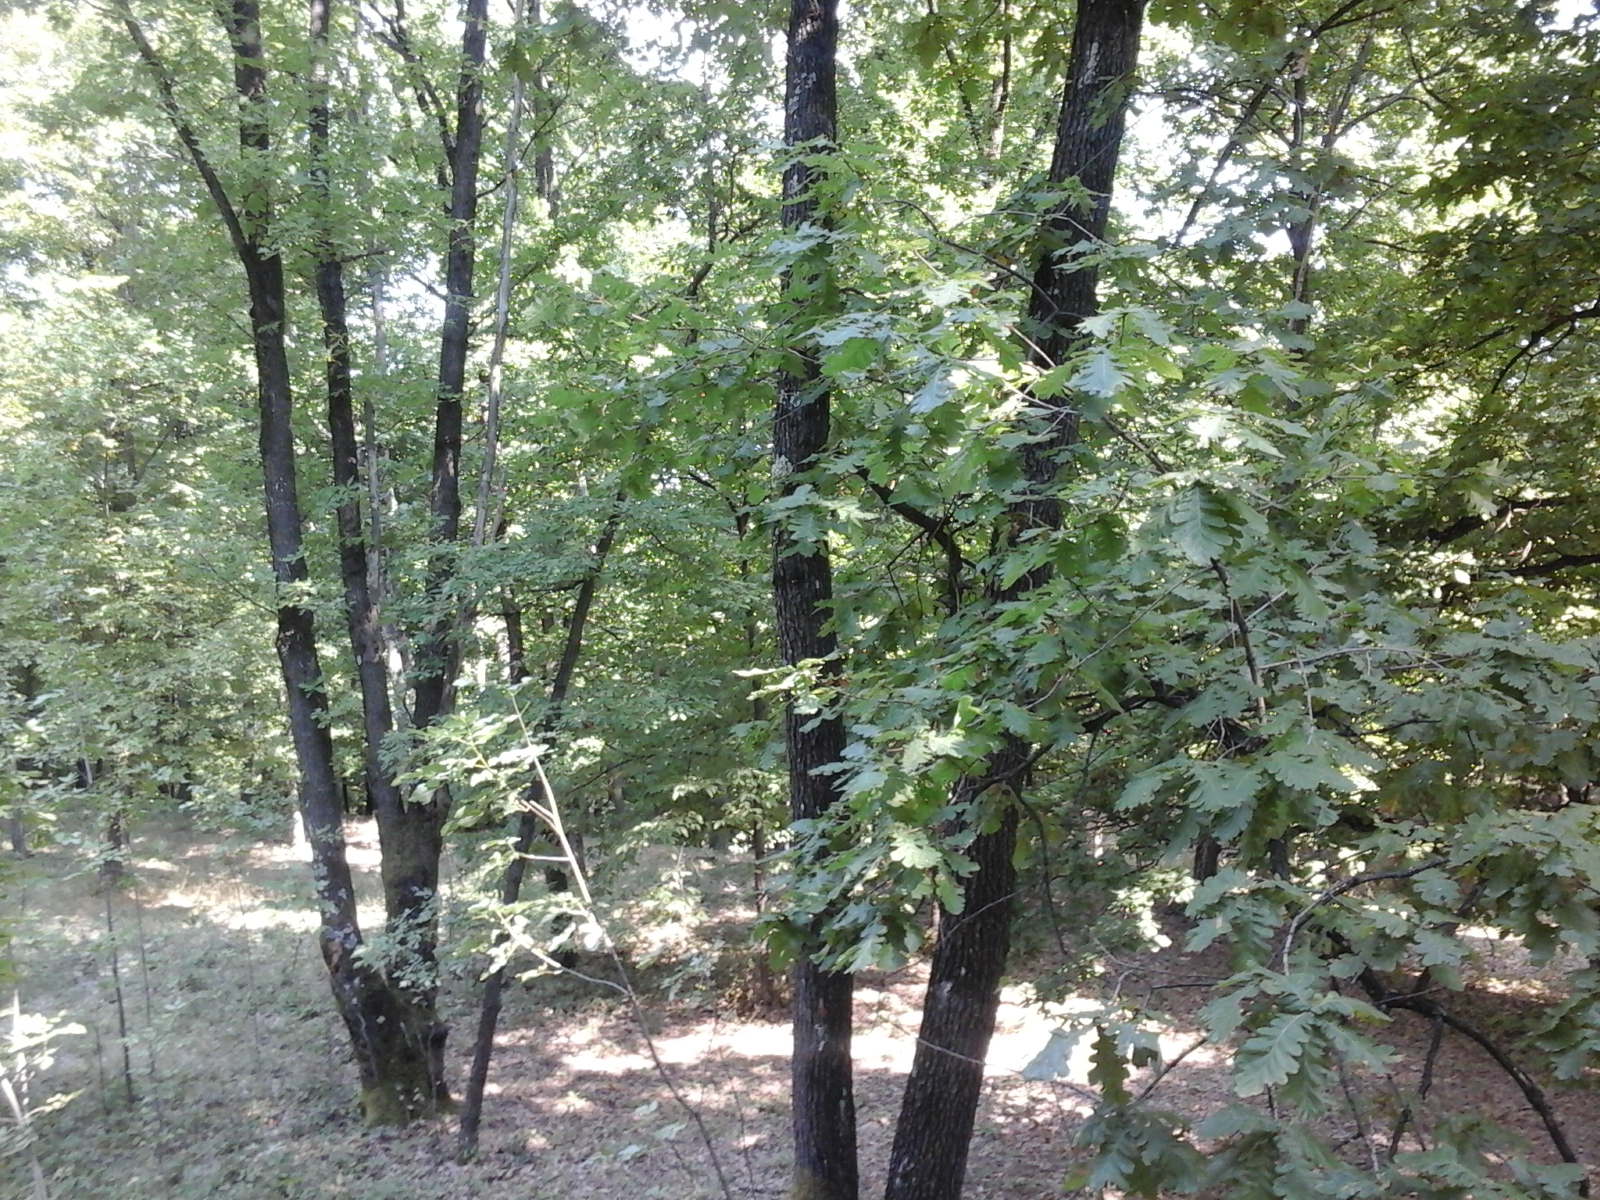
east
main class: Woodland
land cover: Broadleaved woodland
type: acidophilous oak and oak-birch forest
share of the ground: > 75 %
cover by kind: broadleaved forest trees 100 %
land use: Forestry
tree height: > 5 m
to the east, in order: Broadleaved woodland
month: August
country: RO
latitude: 44.8755
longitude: 23.8731
